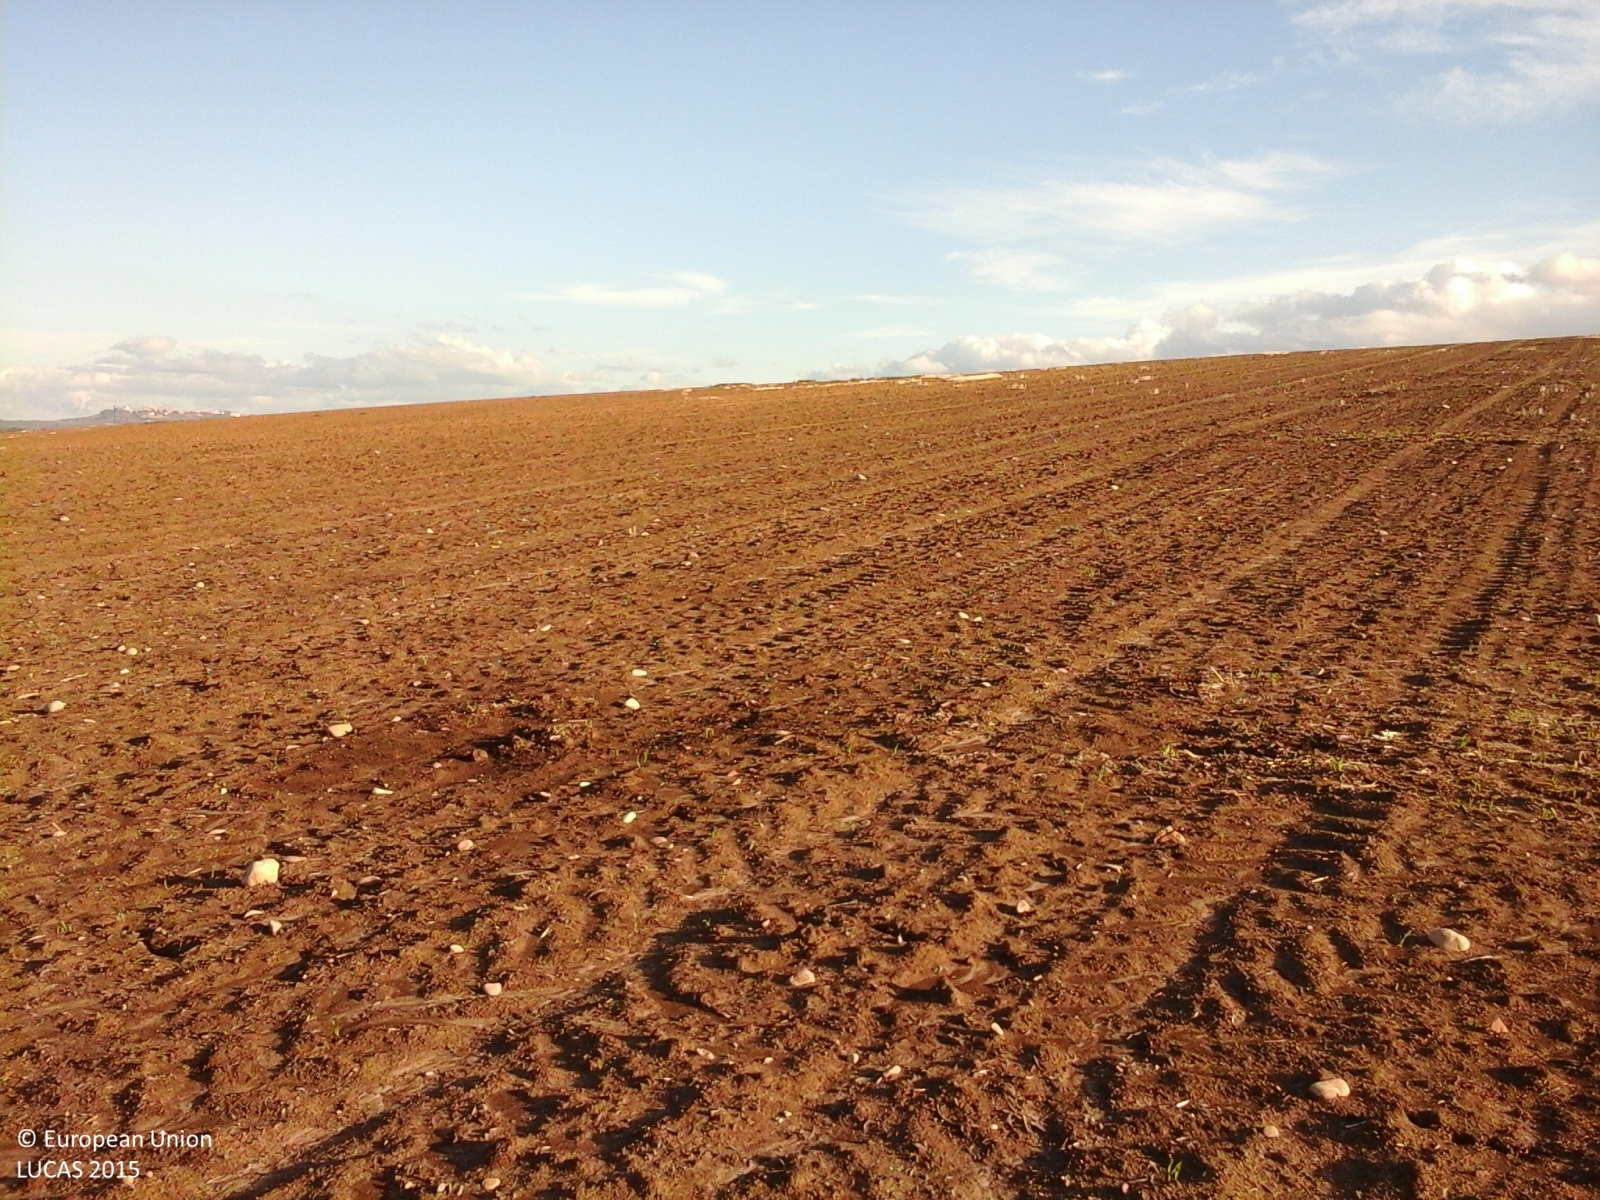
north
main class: Cropland
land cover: Durum wheat
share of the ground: > 75 %
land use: Agriculture (excluding fallow land and kitchen gardens)
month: September
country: IT
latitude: 41.7234
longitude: 15.2125
